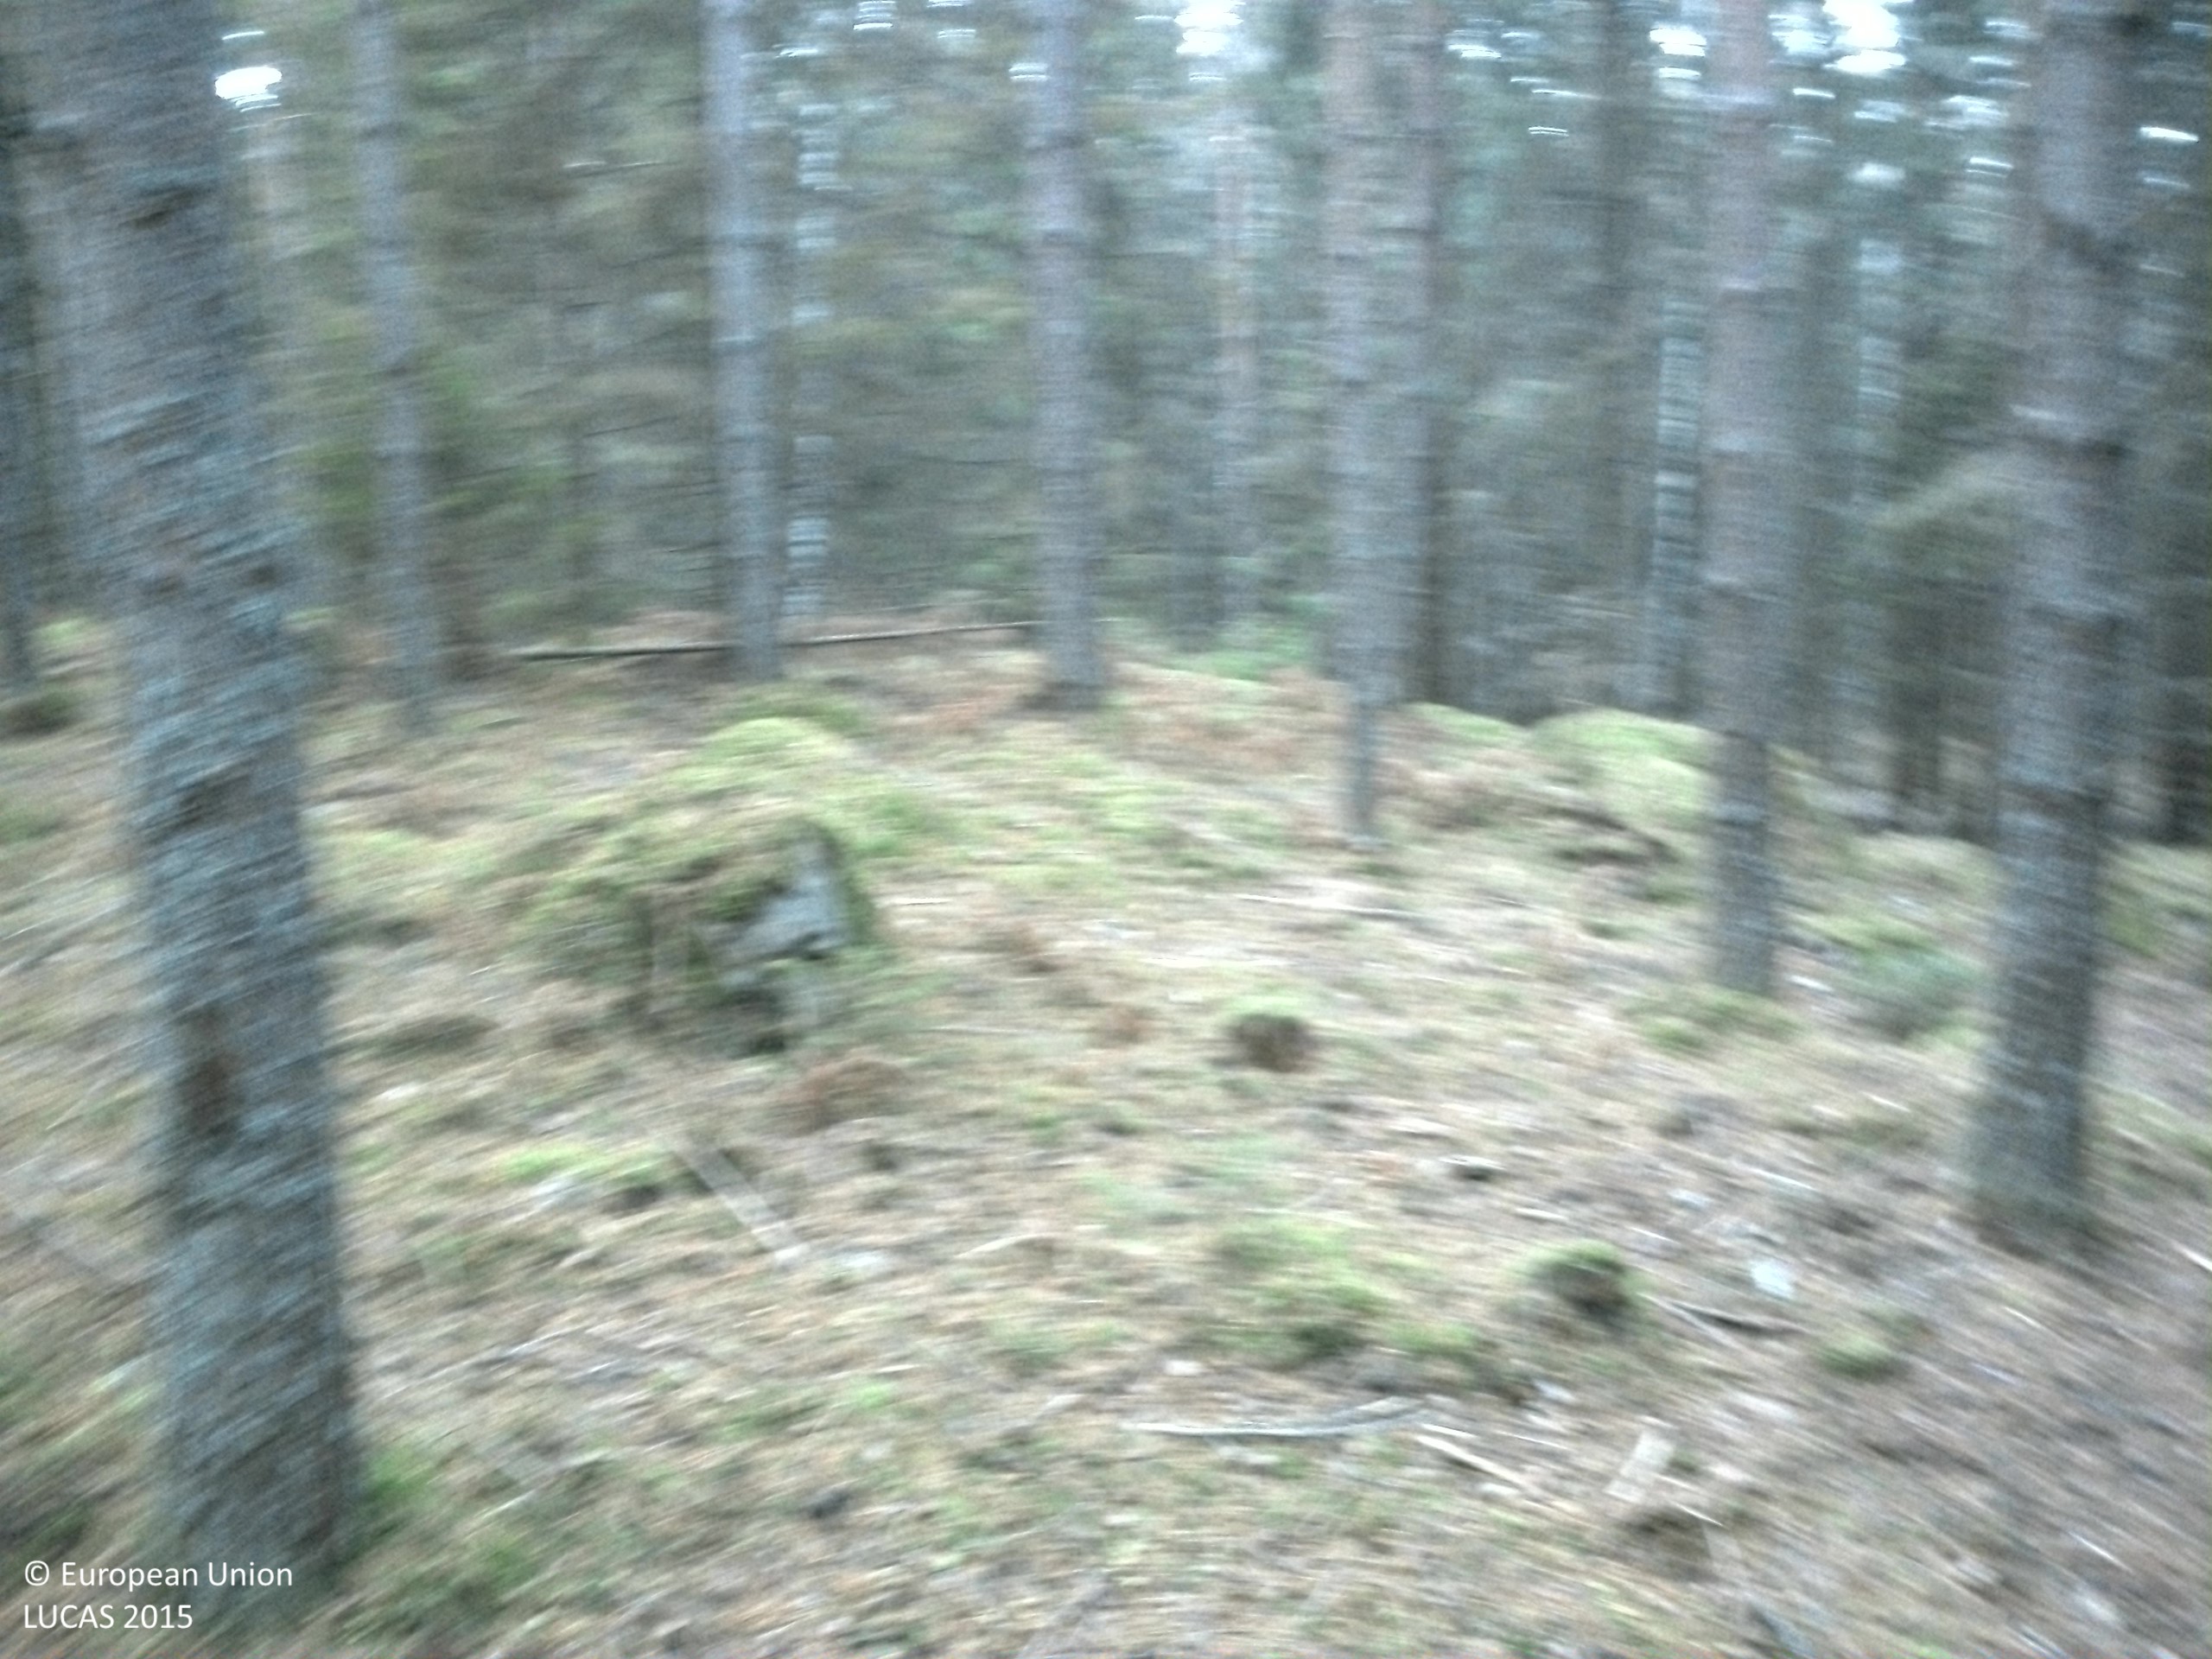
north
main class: Woodland
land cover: Pine dominated coniferous woodland
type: boreal forest
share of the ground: > 75 %
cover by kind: coniferous forest trees 75 %, shrubs 15 %, lichens and mosses 5 %, consolidated bare surface 5 %
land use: Forestry
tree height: > 5 m
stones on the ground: 10 - 25 %
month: November
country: SE
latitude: 58.9295
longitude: 16.8575
